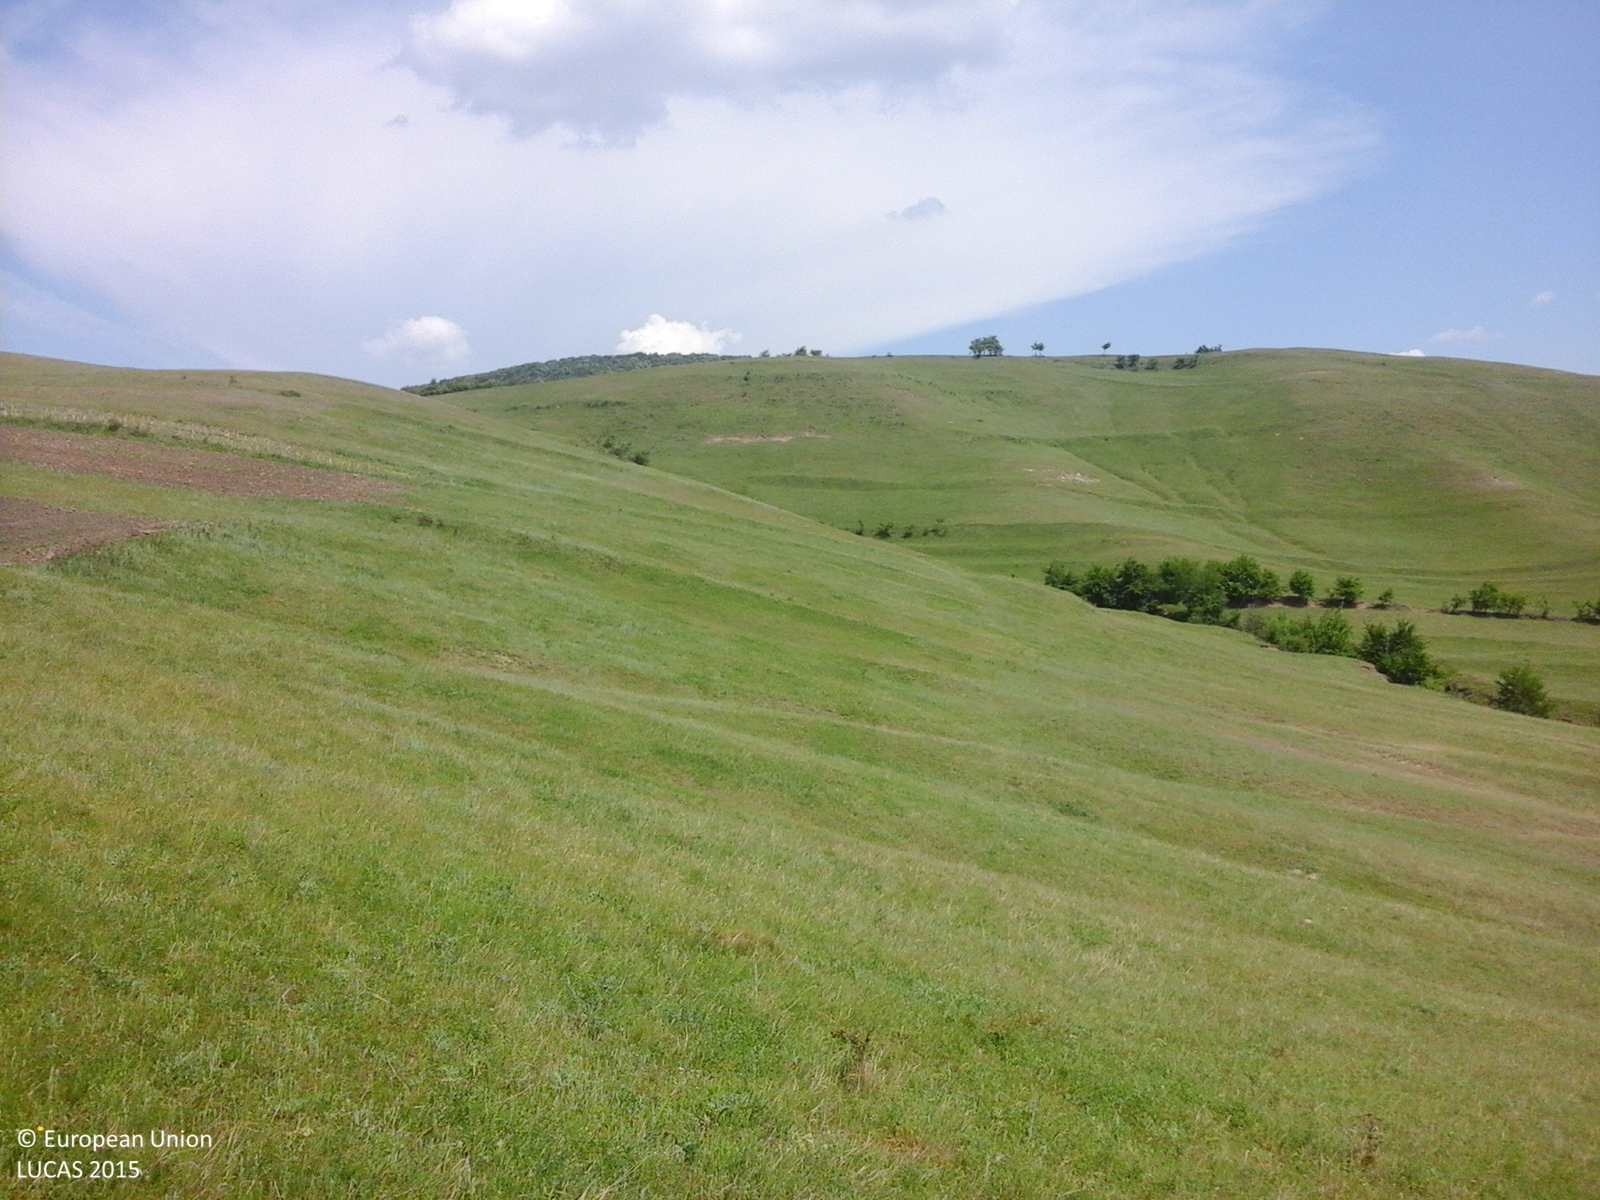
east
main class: Grassland
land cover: Grassland without tree/shrub cover
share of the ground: > 75 %
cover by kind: herbaceous plants 100 %
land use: Agriculture (excluding fallow land and kitchen gardens)
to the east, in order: Grassland without tree/shrub cover; Ditches and canals
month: June
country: RO
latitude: 46.4273
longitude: 27.1331
